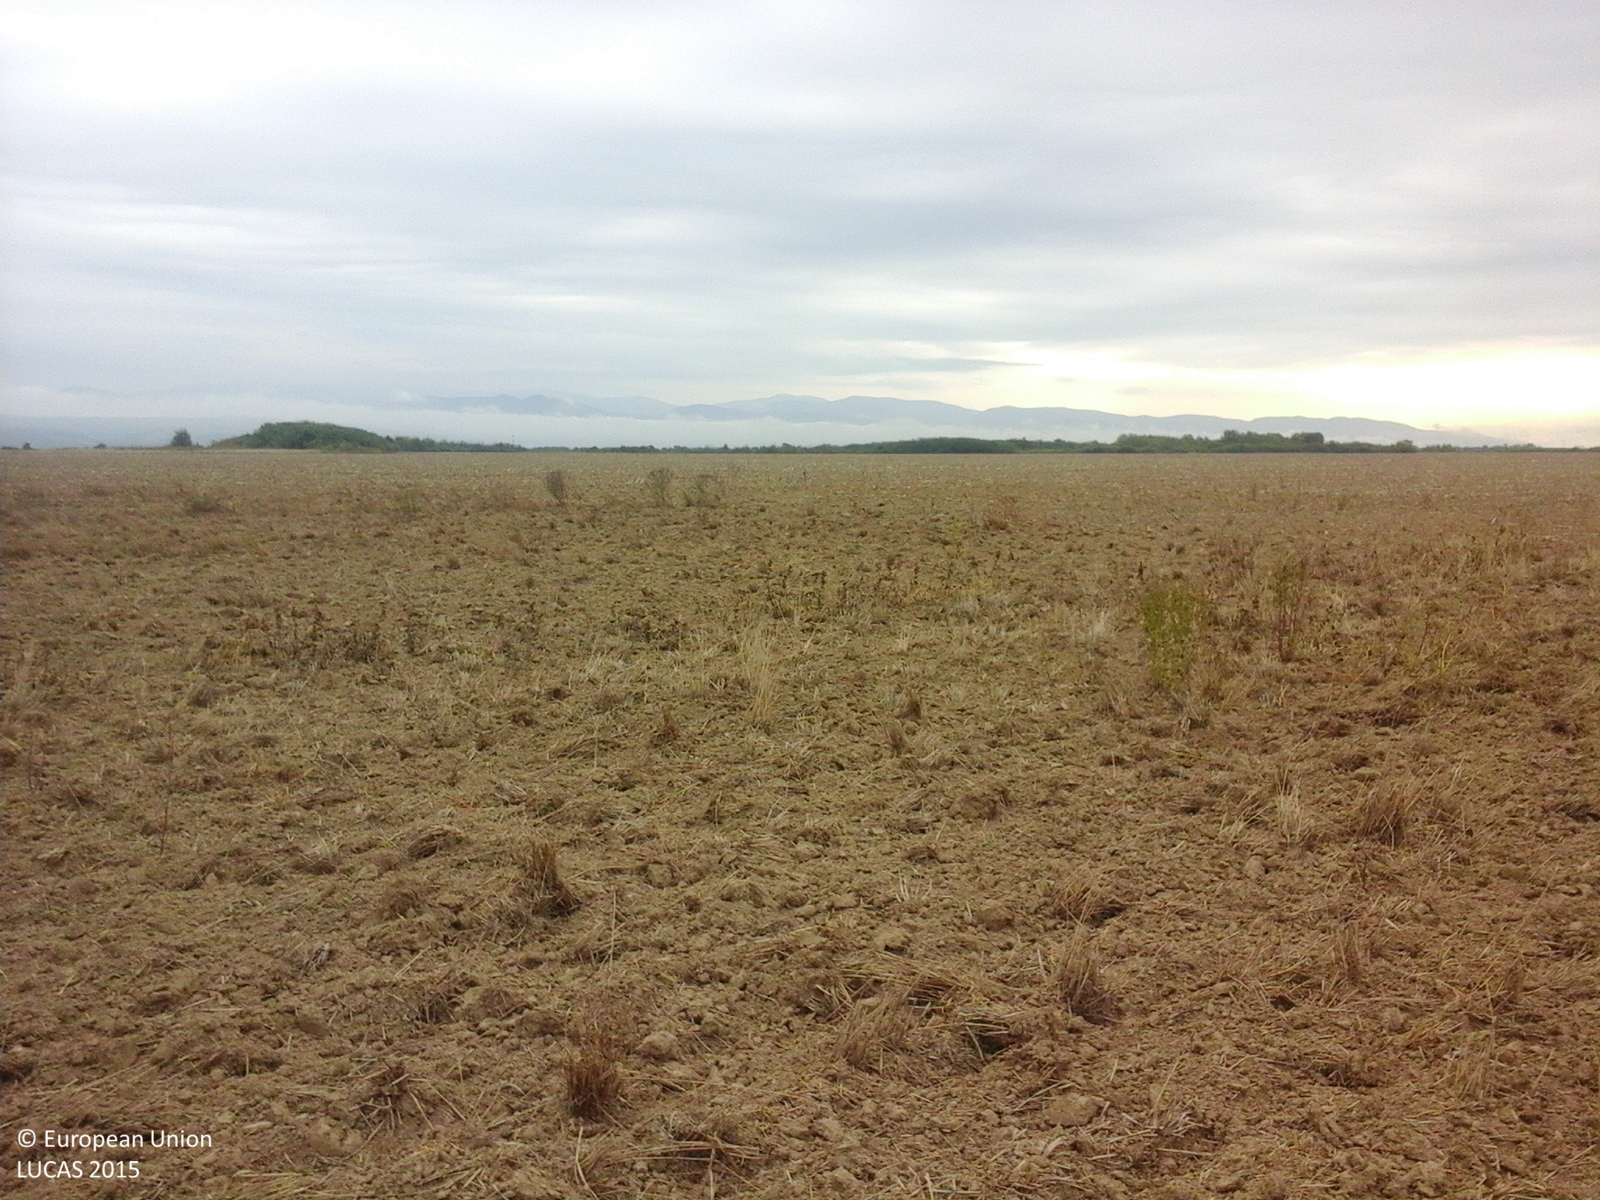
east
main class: Cropland
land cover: Common wheat
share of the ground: < 10 %
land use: Agriculture (excluding fallow land and kitchen gardens)
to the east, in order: Common wheat; Rape and turnip rape
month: September
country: RO
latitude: 45.6207
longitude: 21.9791
